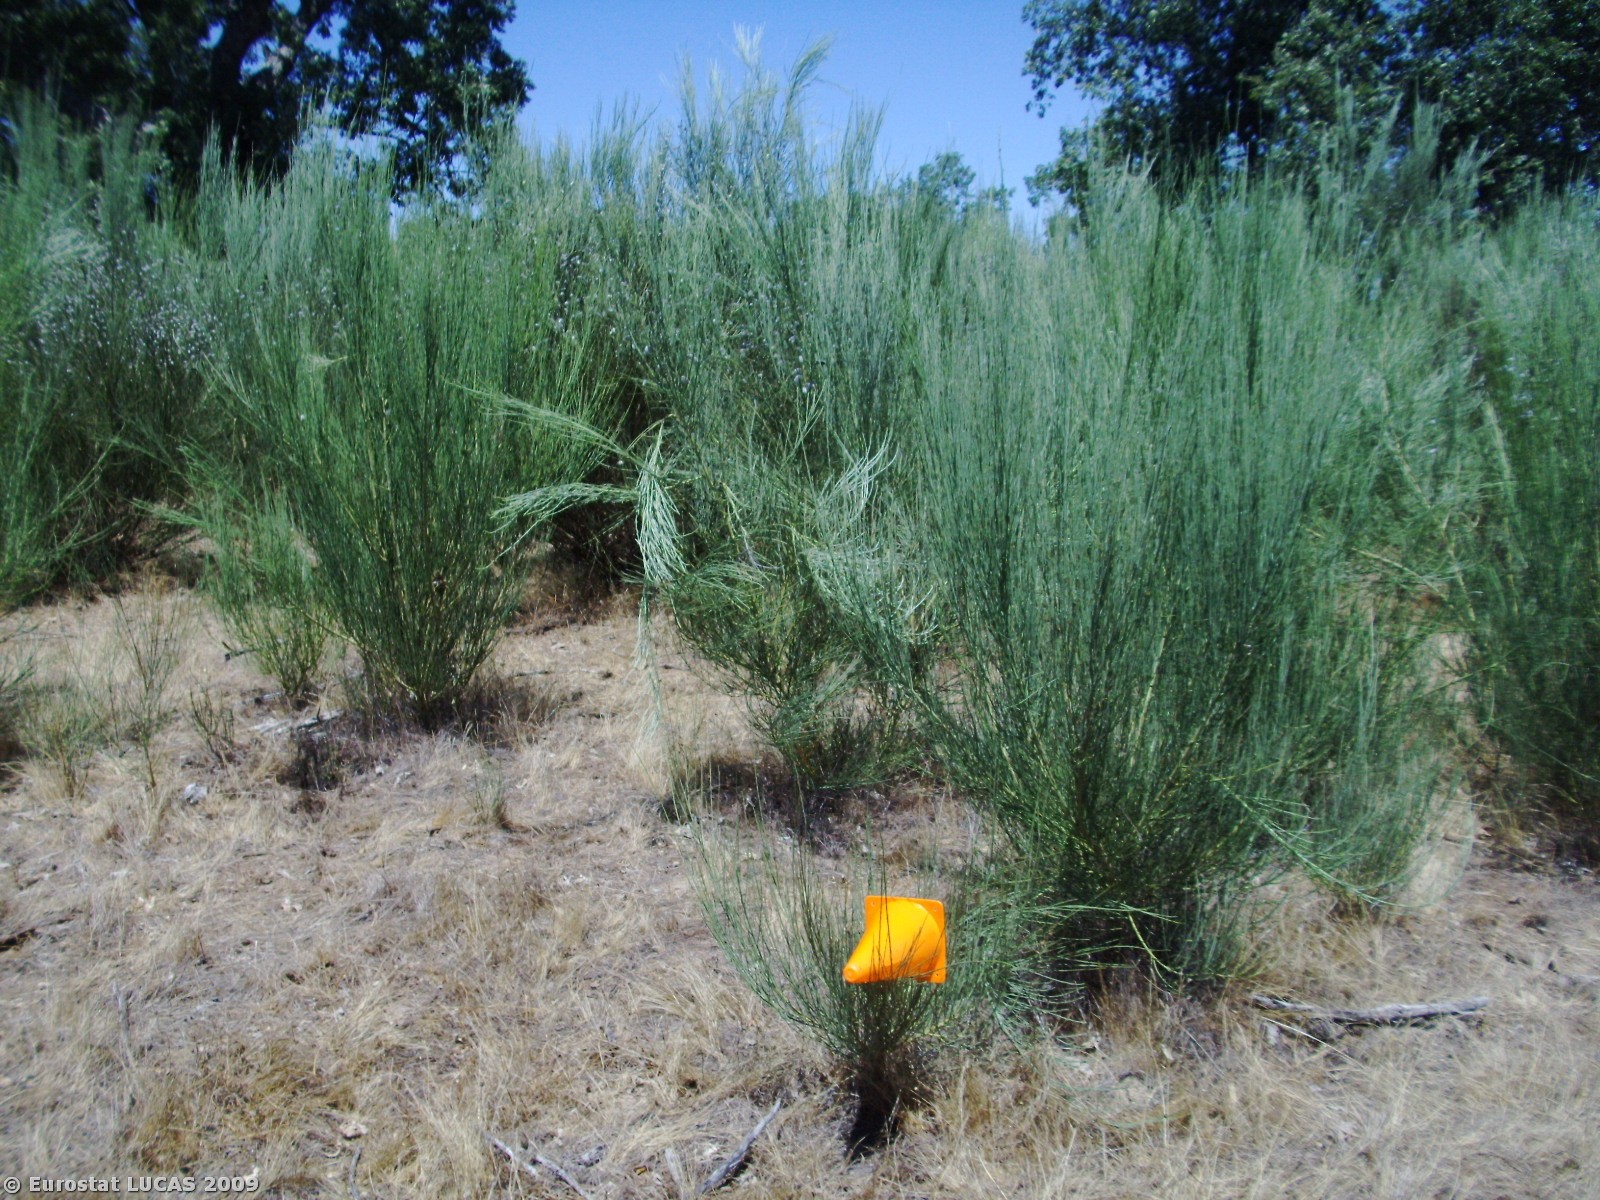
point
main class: Shrubland
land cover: Shrubland with sparse tree cover
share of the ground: > 75 %
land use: Forestry
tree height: > 5 m
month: July
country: PT
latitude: 40.5366
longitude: -7.2358
